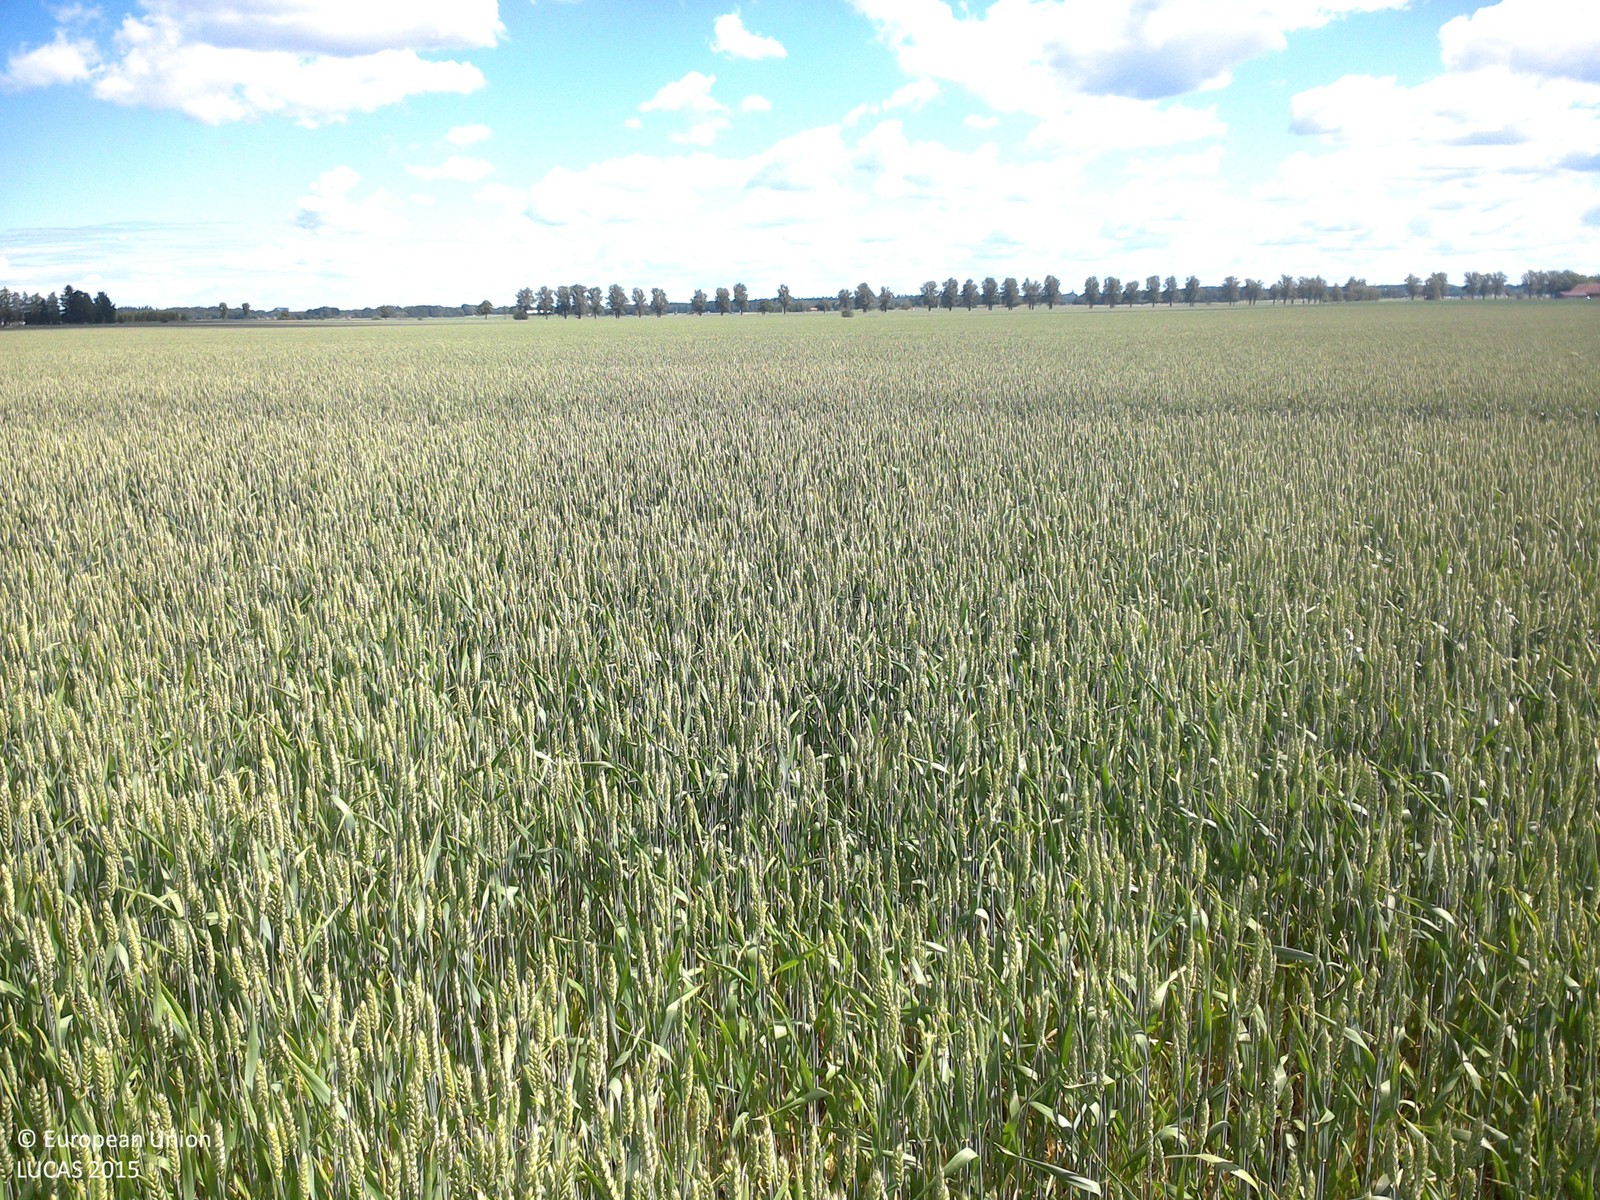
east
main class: Cropland
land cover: Common wheat
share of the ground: > 75 %
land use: Agriculture (excluding fallow land and kitchen gardens)
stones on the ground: < 10 %
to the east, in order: Common wheat
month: July
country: SE
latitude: 58.3782
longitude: 15.4836
